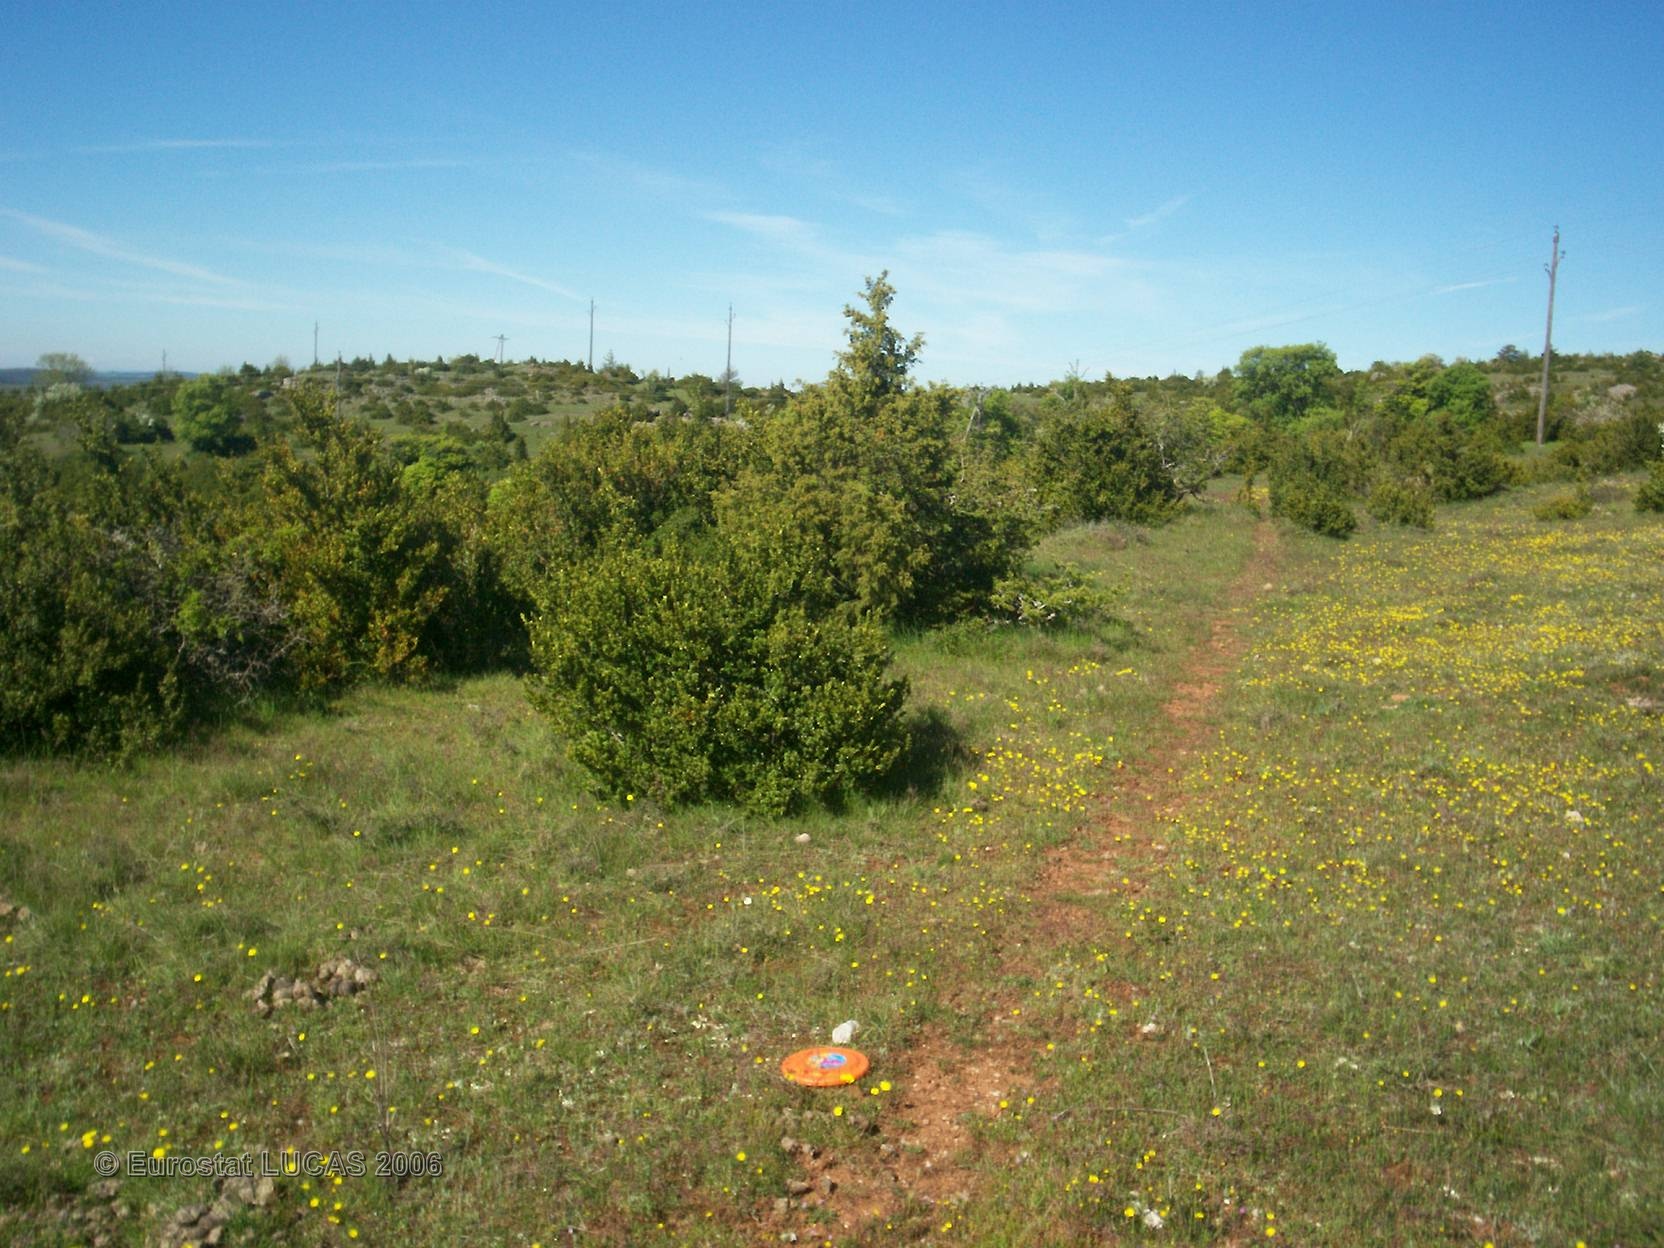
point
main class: Grassland
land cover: Grassland with sparse tree/shrub cover
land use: Agriculture (excluding fallow land and kitchen gardens)
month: May
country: FR
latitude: 43.9588
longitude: 3.3897
